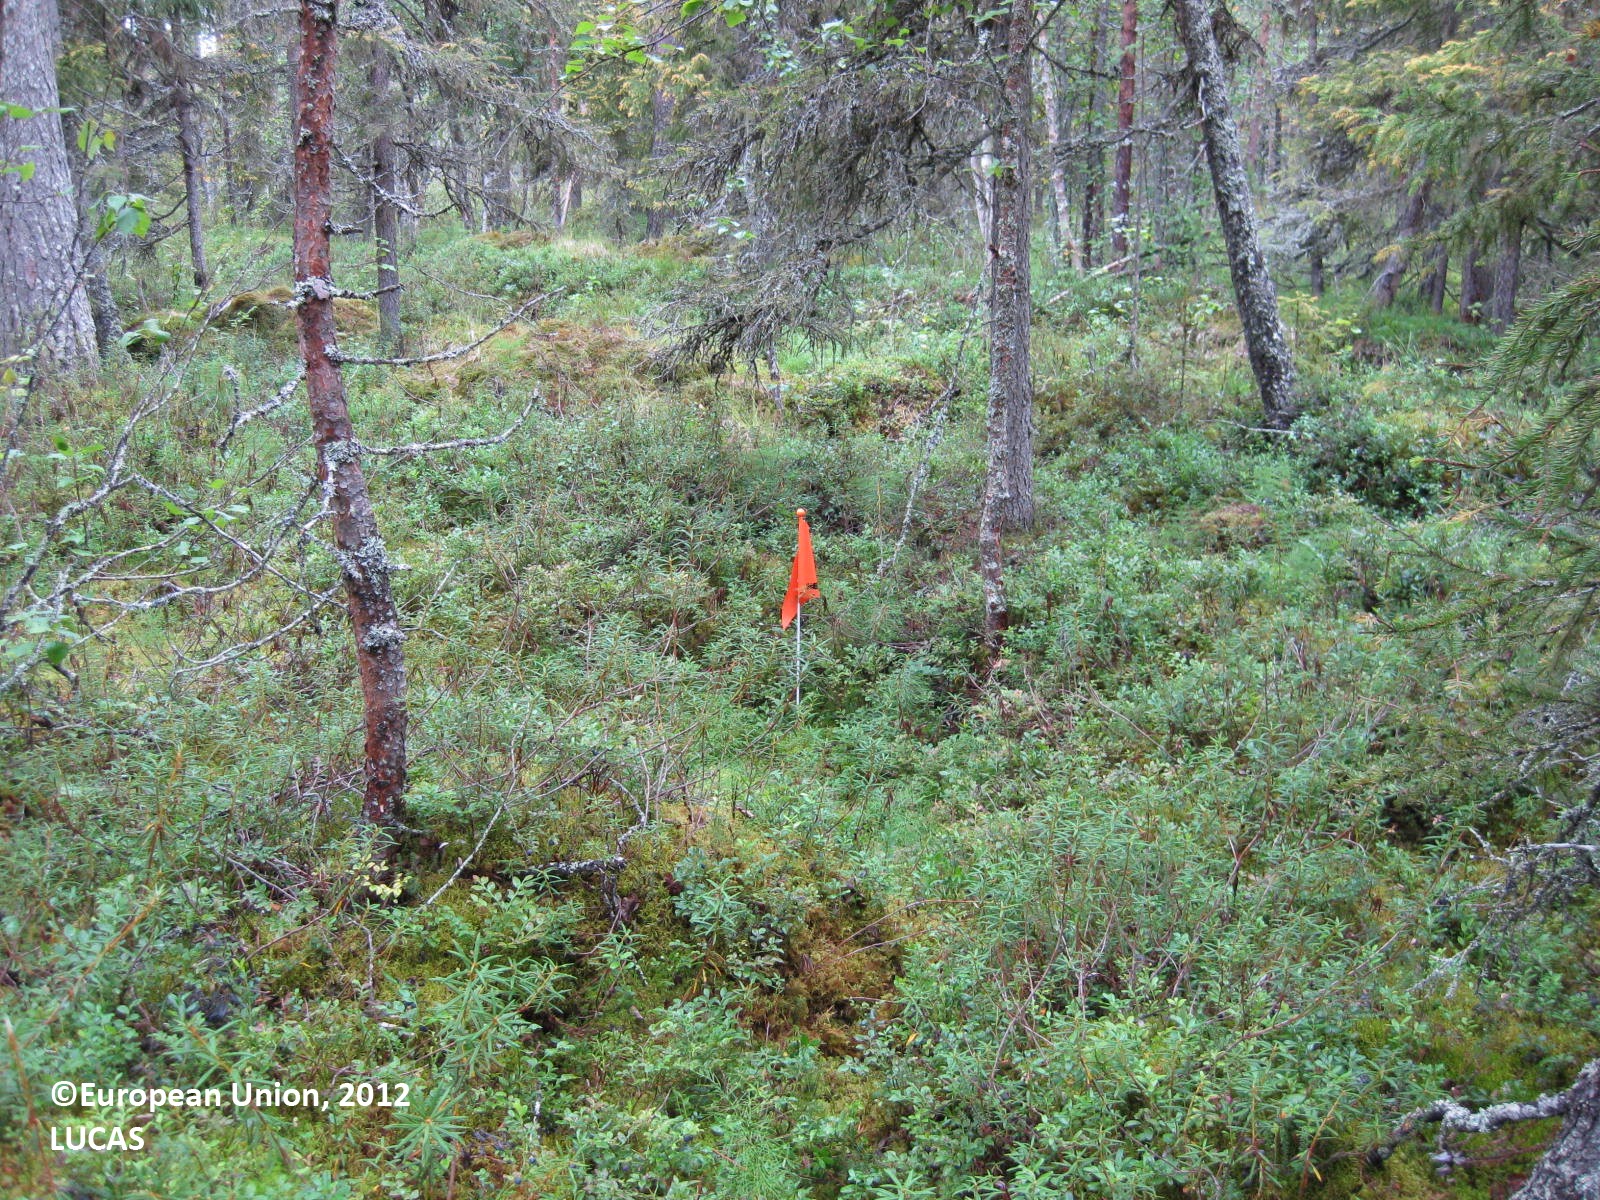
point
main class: Woodland
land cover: Spruce dominated coniferous woodland
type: boreal forest
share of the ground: > 75 %
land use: Forestry
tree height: > 5 m
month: August
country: FI
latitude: 65.8845
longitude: 28.2427
